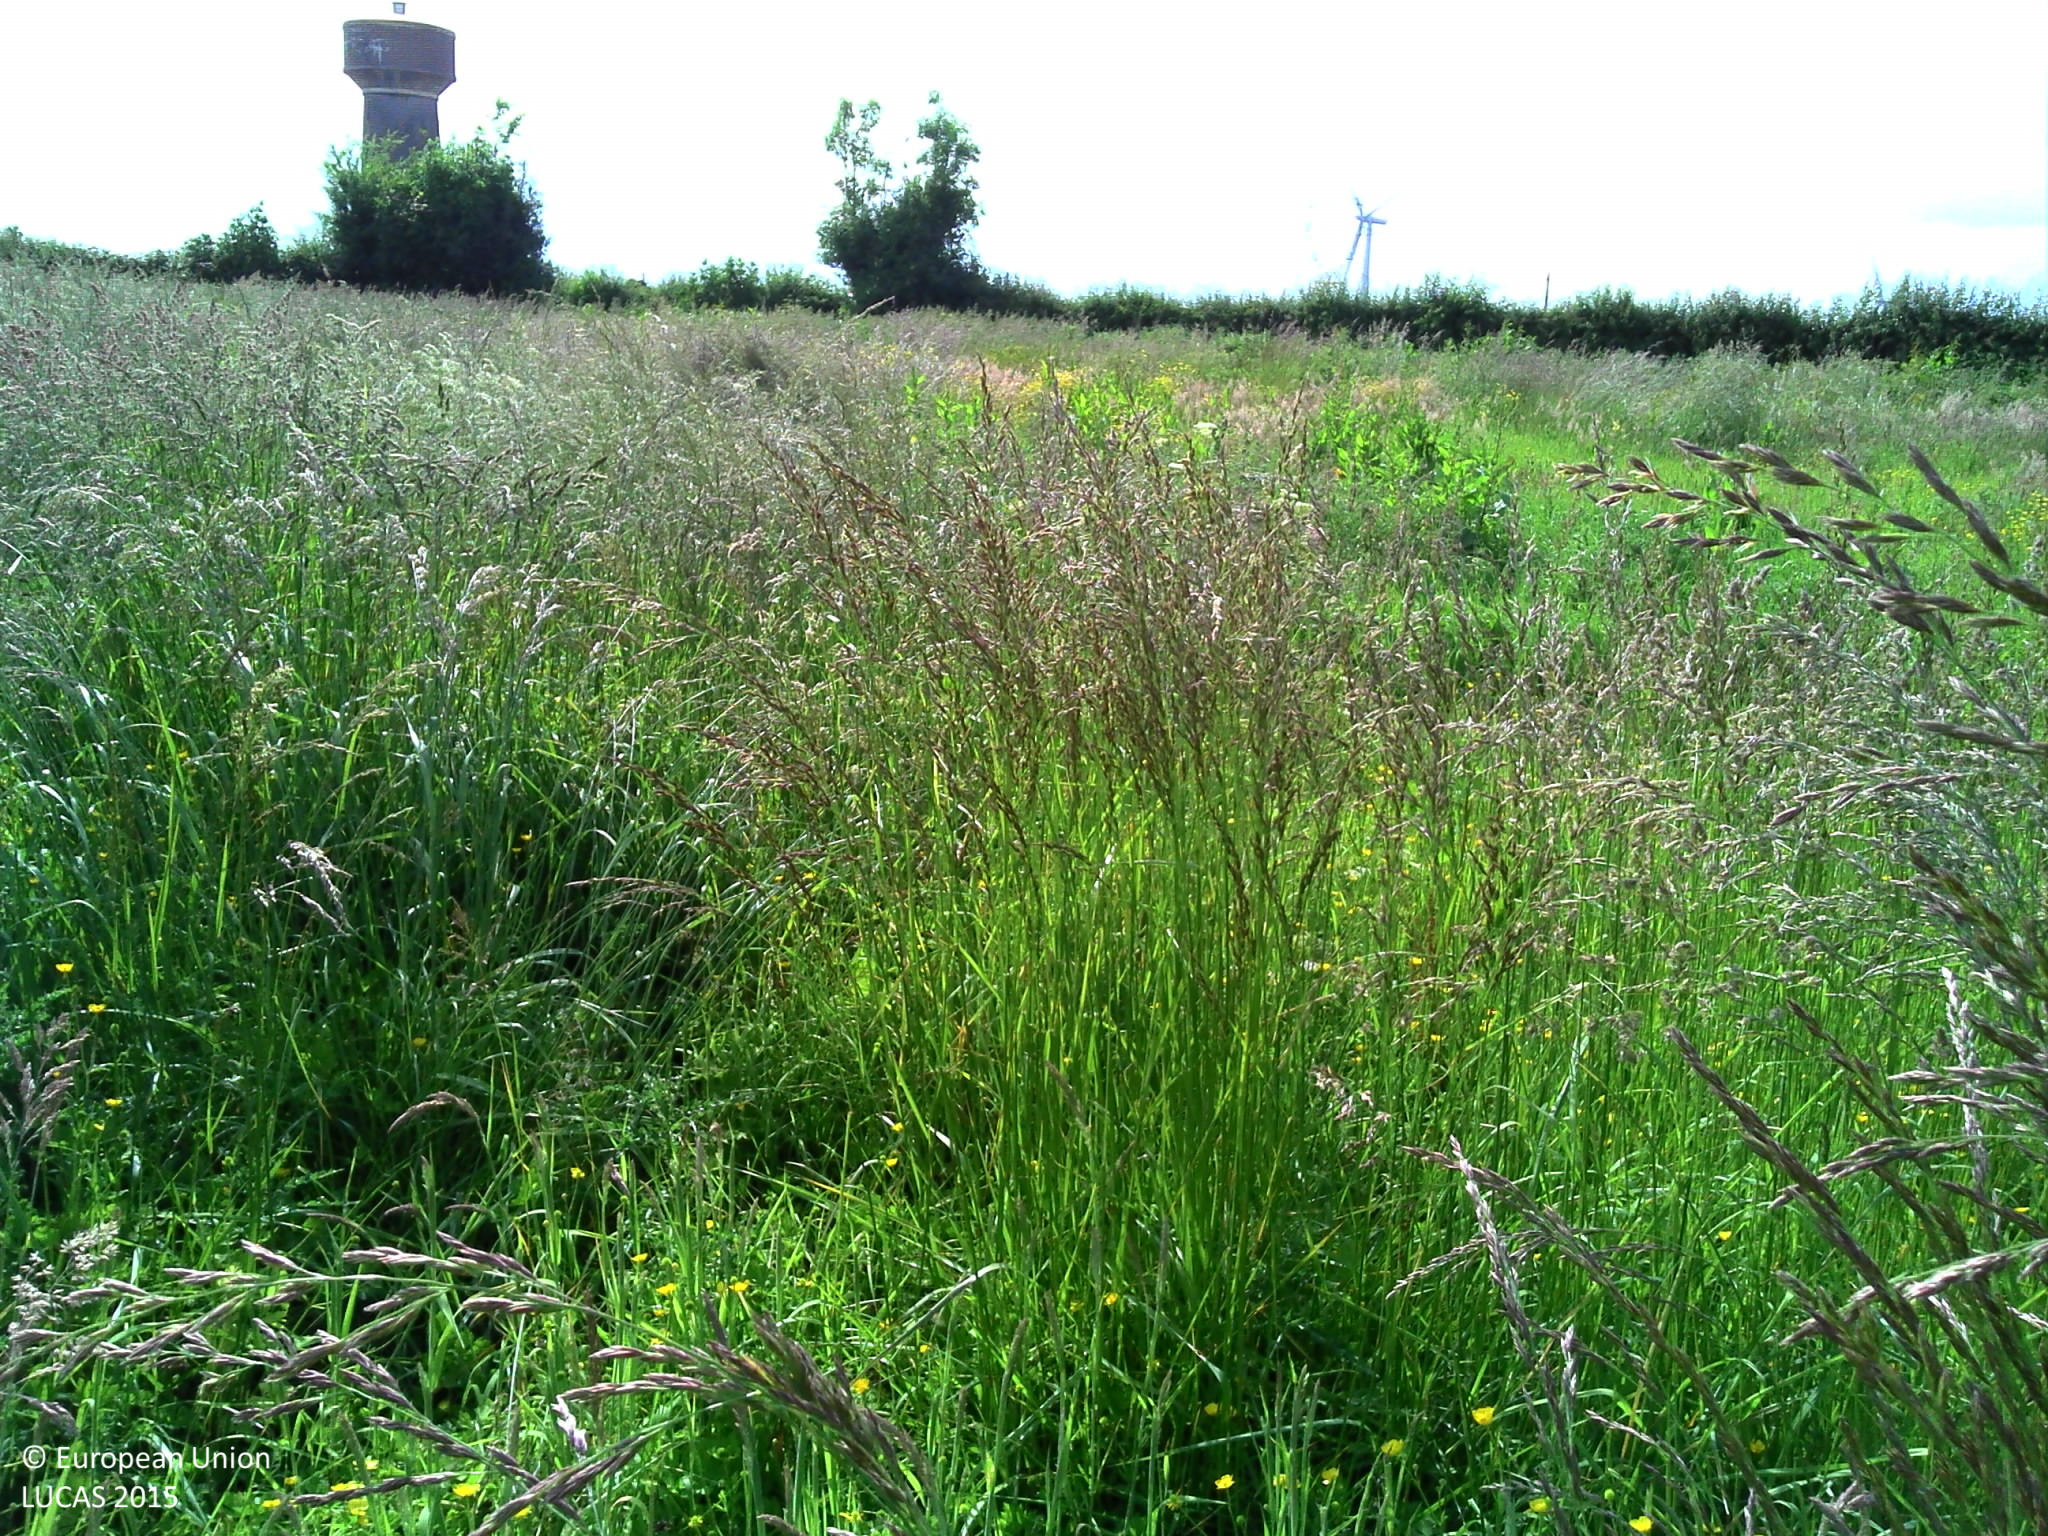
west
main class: Grassland
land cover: Grassland without tree/shrub cover
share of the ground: > 75 %
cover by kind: herbaceous plants 90 %
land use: Agriculture (excluding fallow land and kitchen gardens)
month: June
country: FR
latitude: 50.4341
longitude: 2.3700
